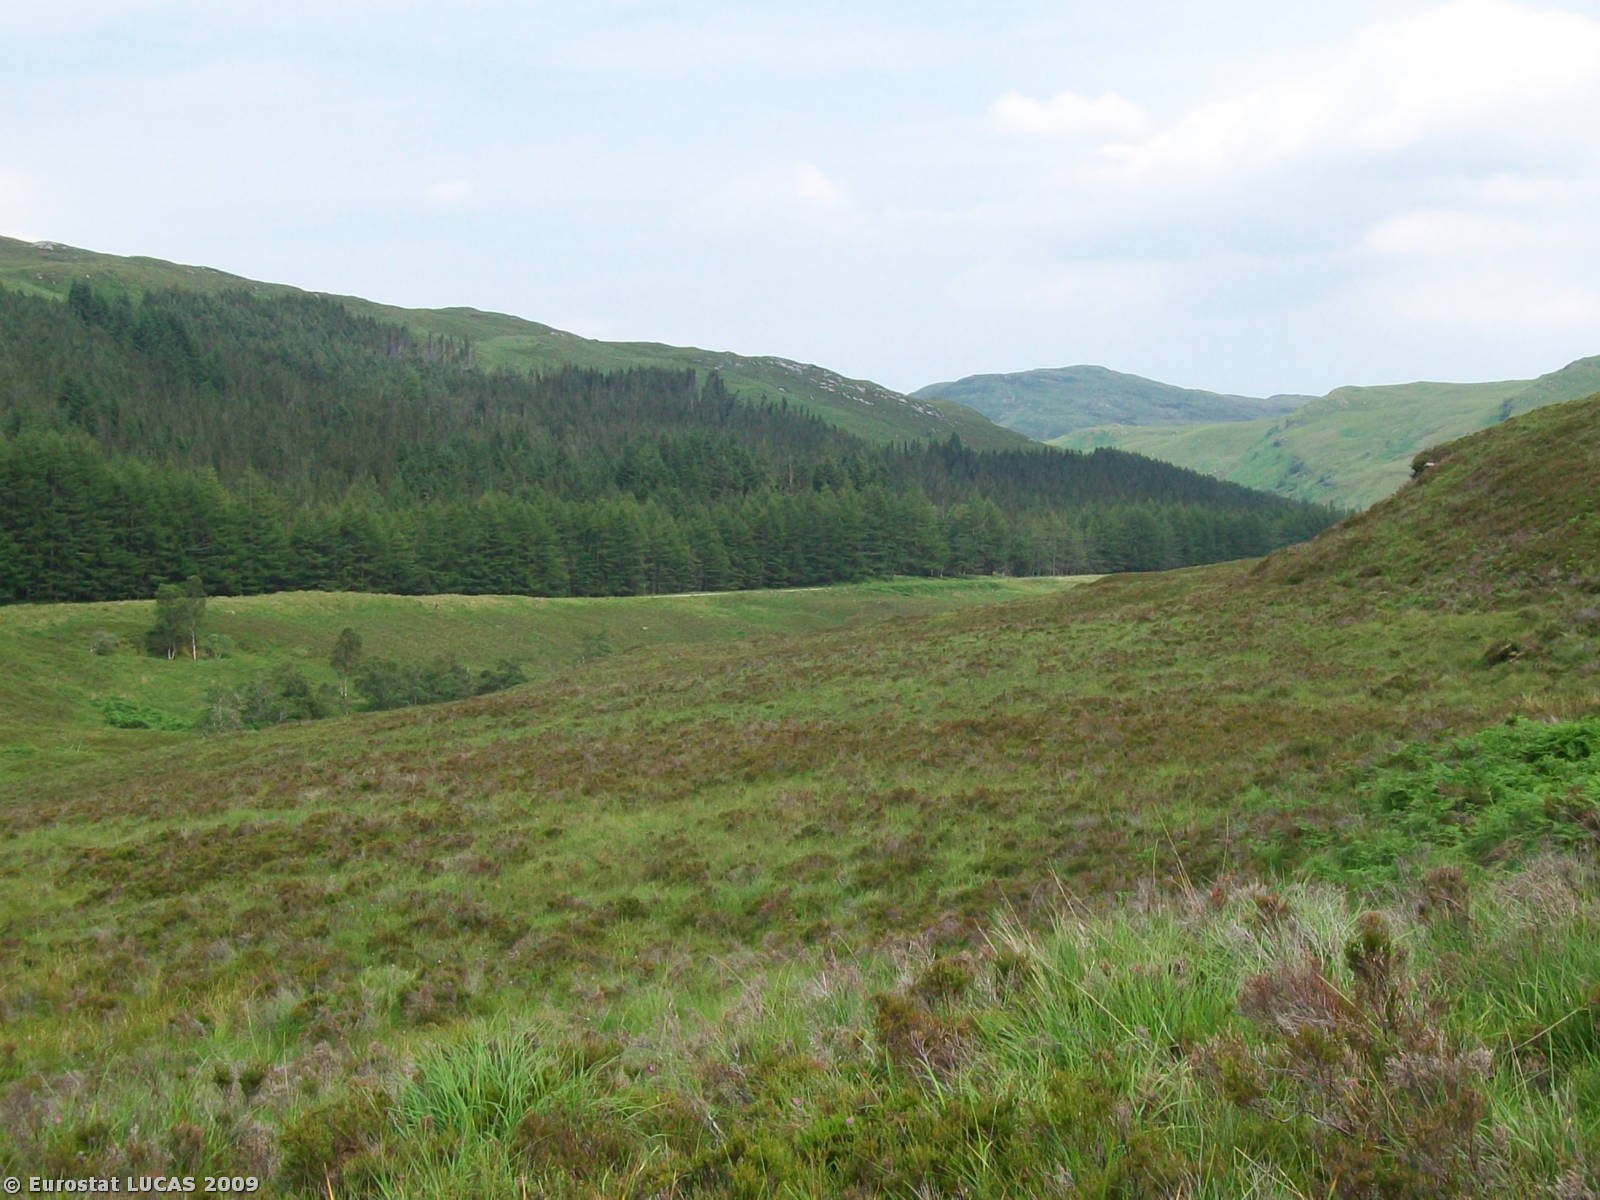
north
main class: Shrubland
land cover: Shrubland without tree cover
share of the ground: > 75 %
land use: Unused
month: July
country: GB
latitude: 57.7925
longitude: -5.1605
